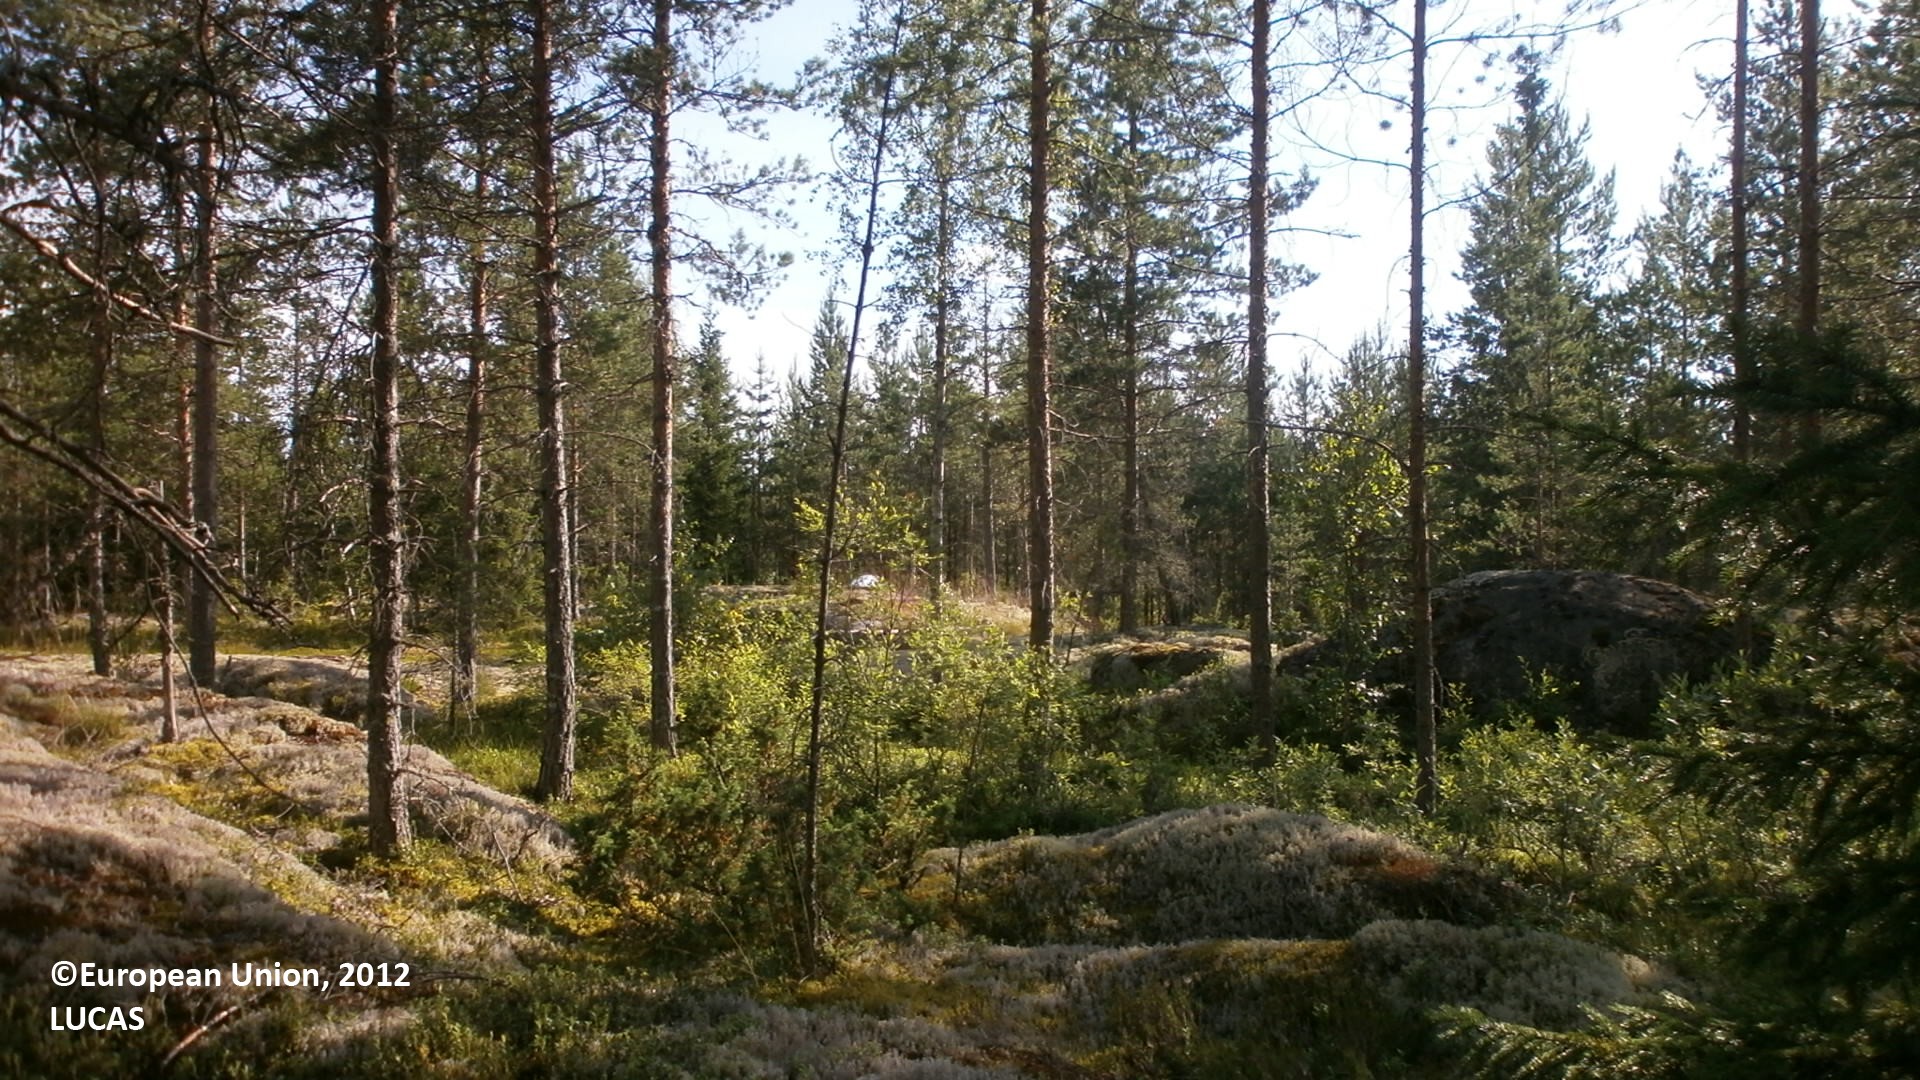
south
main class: Woodland
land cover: Pine dominated coniferous woodland
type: boreal forest
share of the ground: 50 - 75 %
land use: Forestry
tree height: > 5 m
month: July
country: FI
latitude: 64.1814
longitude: 24.3729
